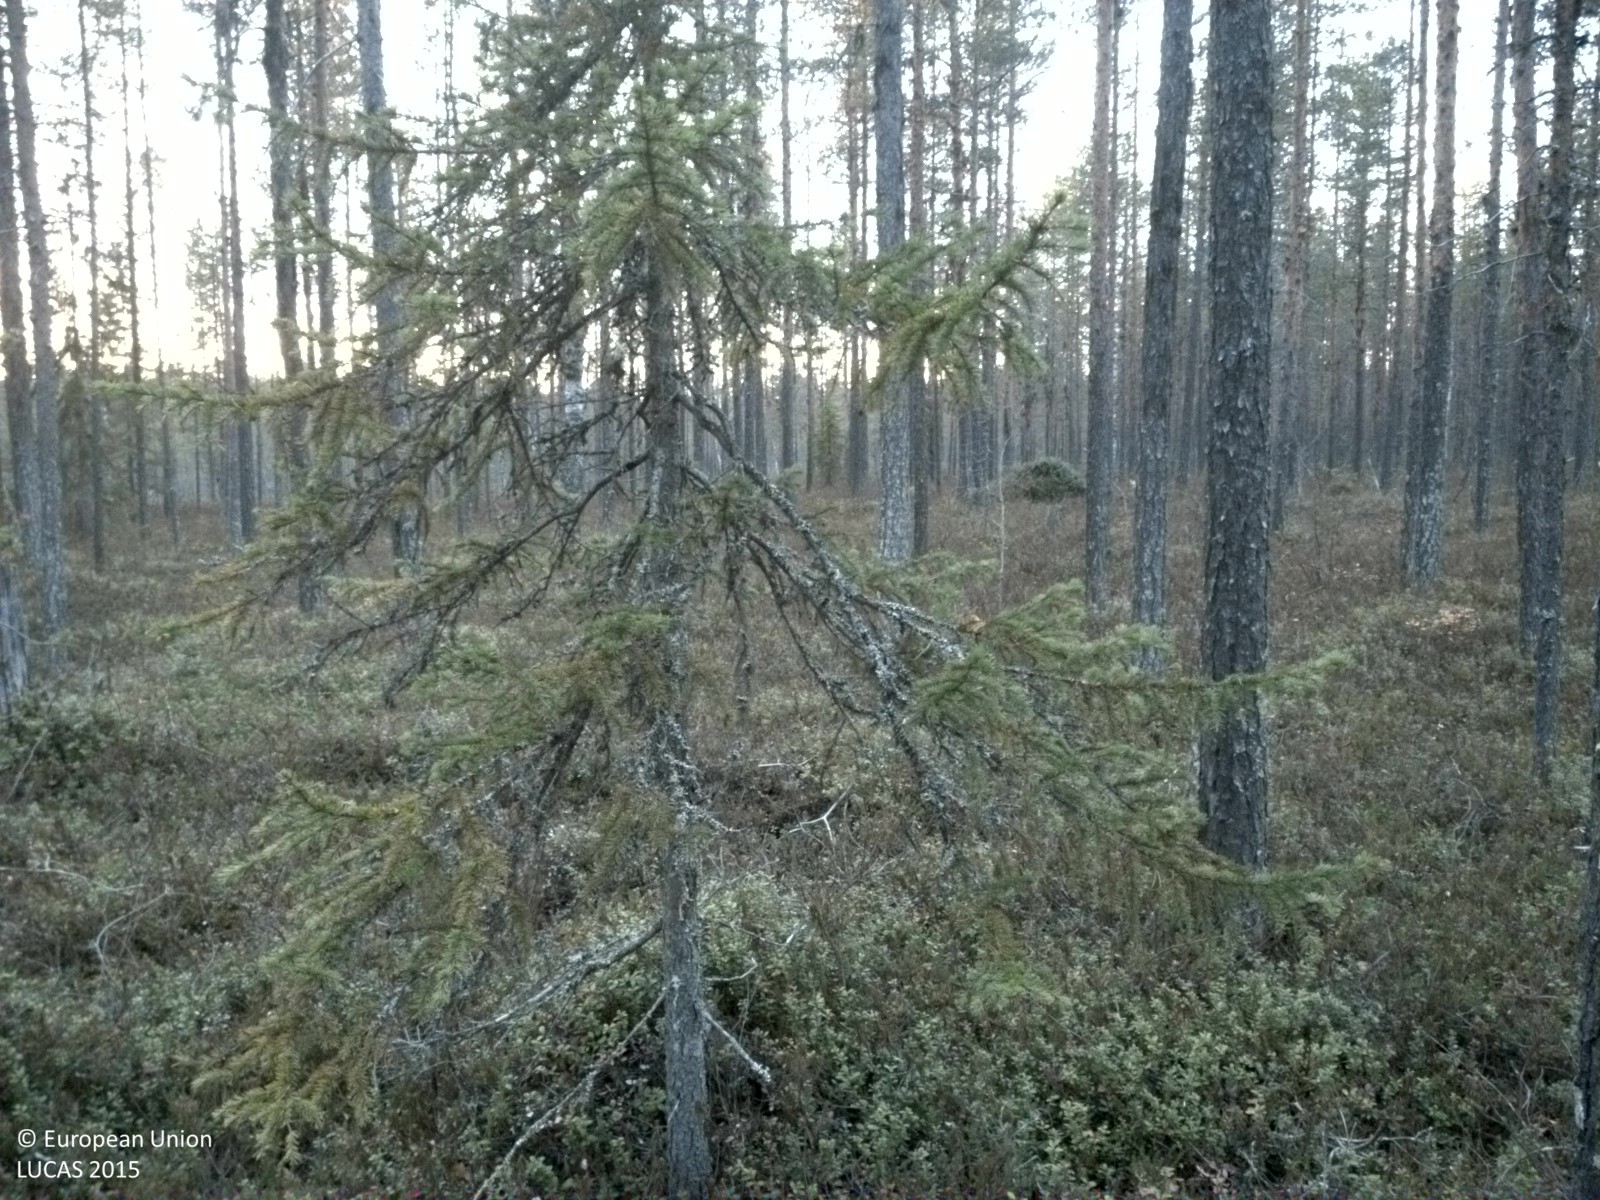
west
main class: Woodland
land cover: Pine dominated coniferous woodland
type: boreal forest
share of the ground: 25 - 50 %
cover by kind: shrubs 70 %, coniferous forest trees 30 %
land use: Forestry
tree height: > 5 m
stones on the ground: > 50 %
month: October
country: SE
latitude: 65.8776
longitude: 20.4665
